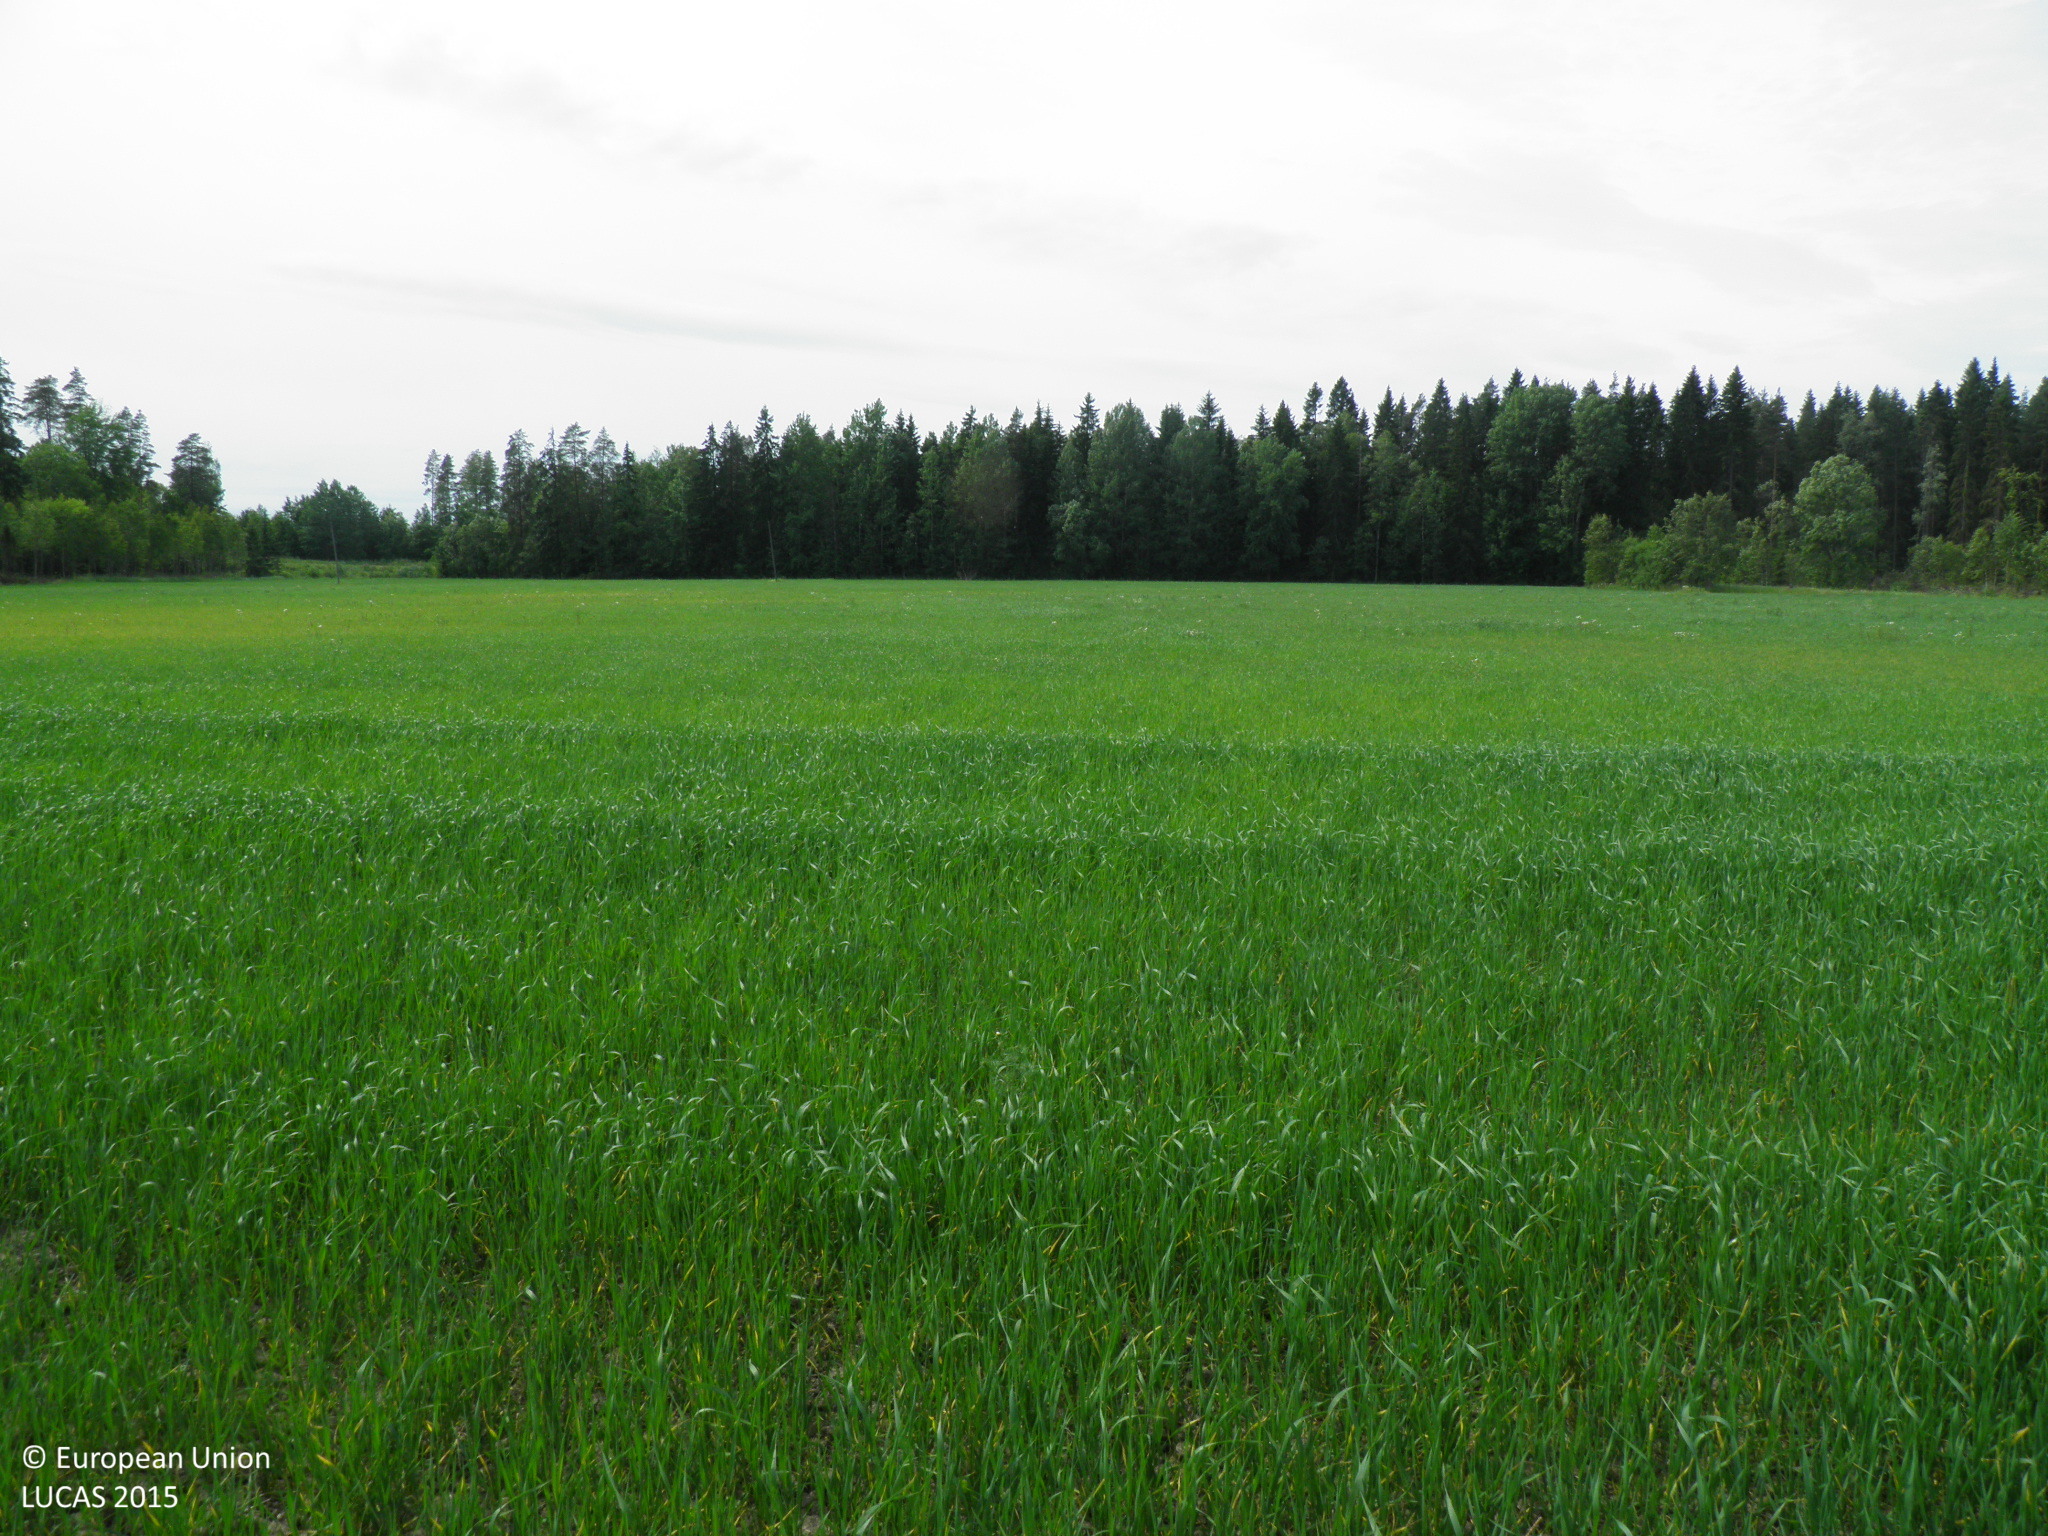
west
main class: Cropland
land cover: Common wheat
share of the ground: > 75 %
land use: Agriculture (excluding fallow land and kitchen gardens)
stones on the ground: < 10 %
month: July
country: FI
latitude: 60.7151
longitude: 22.7364
